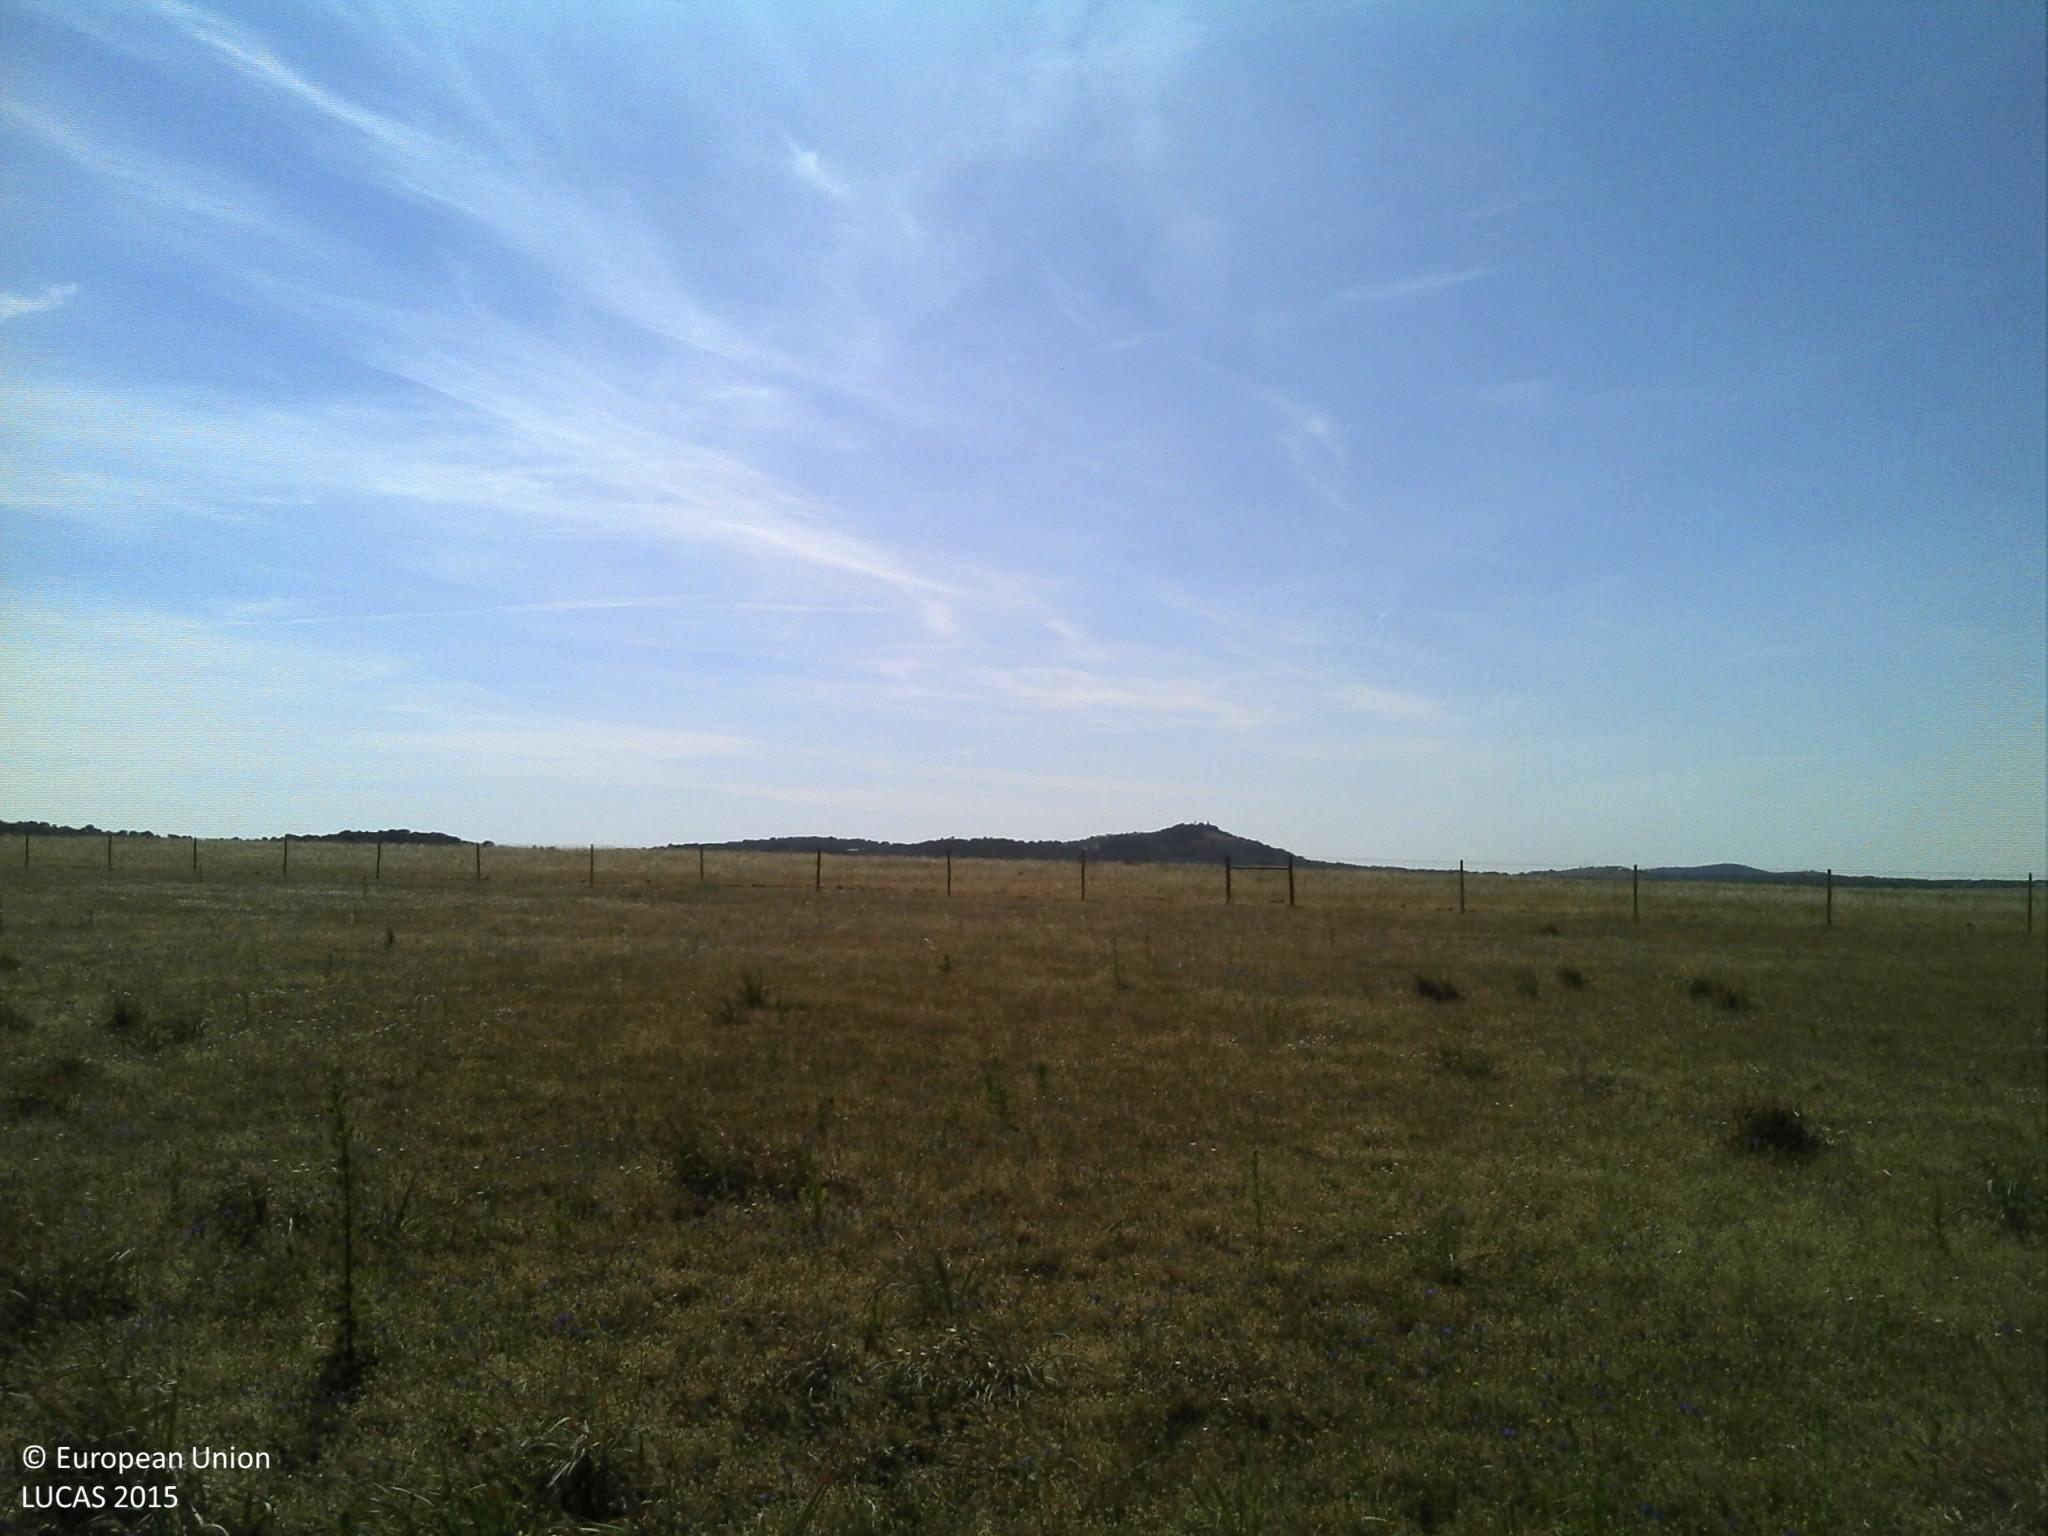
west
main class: Grassland
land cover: Grassland without tree/shrub cover
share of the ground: 50 - 75 %
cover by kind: herbaceous plants 85 %, unconsolidated bare surface 15 %
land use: Agriculture (excluding fallow land and kitchen gardens)
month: May
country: PT
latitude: 39.1826
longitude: -7.5814
